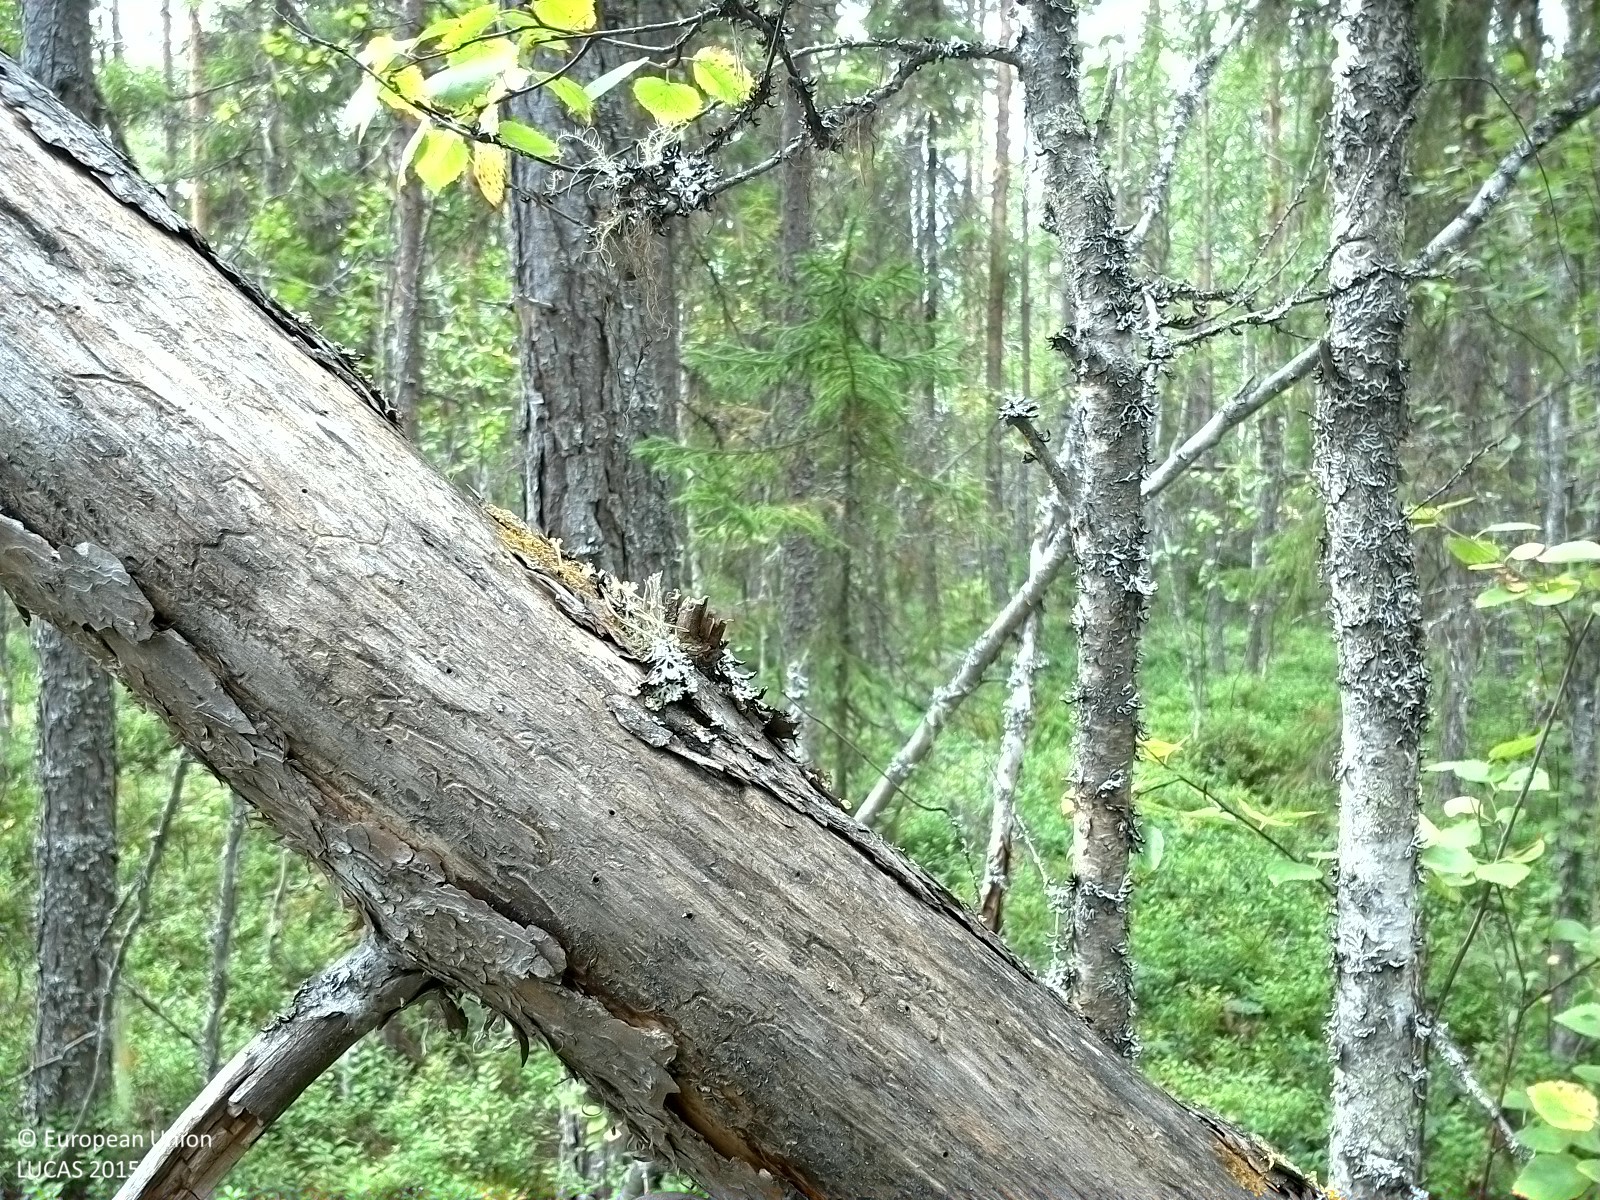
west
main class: Woodland
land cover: Spruce dominated mixed woodland
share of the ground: 50 - 75 %
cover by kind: shrubs 45 %, coniferous forest trees 40 %, broadleaved forest trees 15 %
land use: Forestry
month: August
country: SE
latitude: 62.4094
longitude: 16.2696
